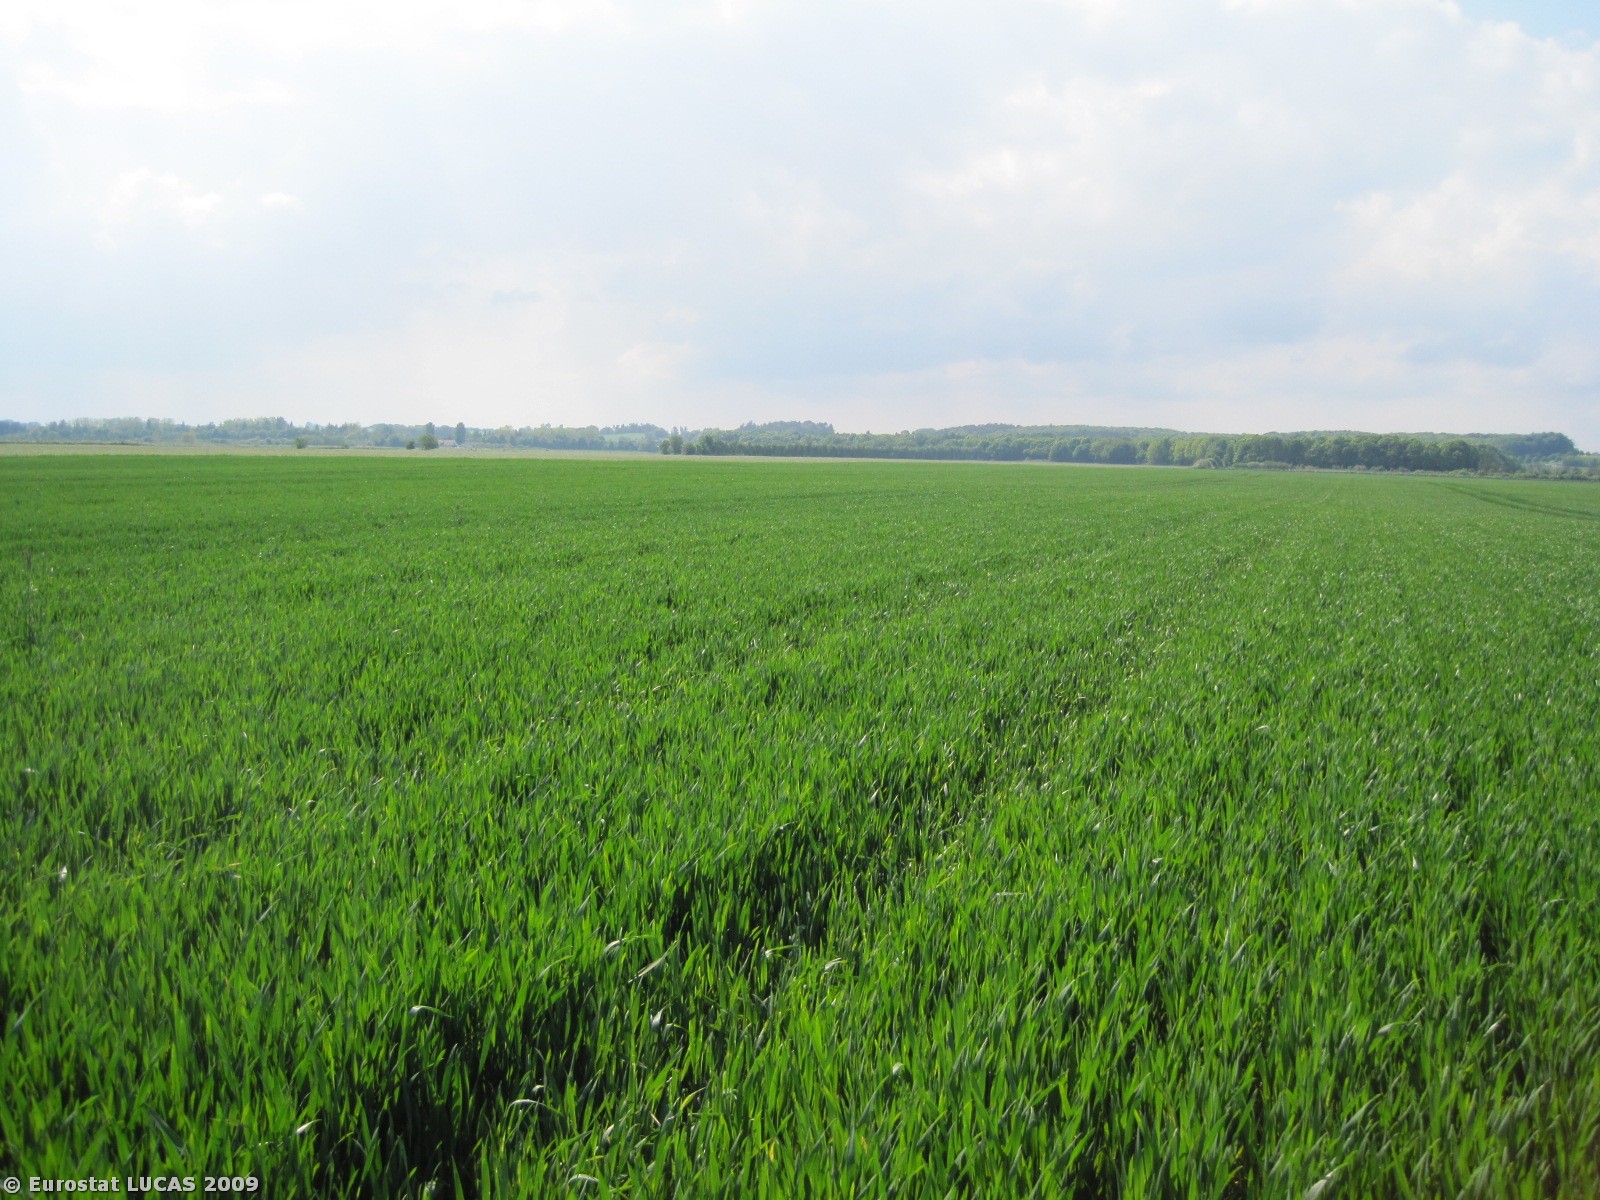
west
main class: Cropland
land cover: Common wheat
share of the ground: > 75 %
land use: Agriculture (excluding fallow land and kitchen gardens)
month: May
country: DK
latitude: 56.6728
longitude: 10.2770
